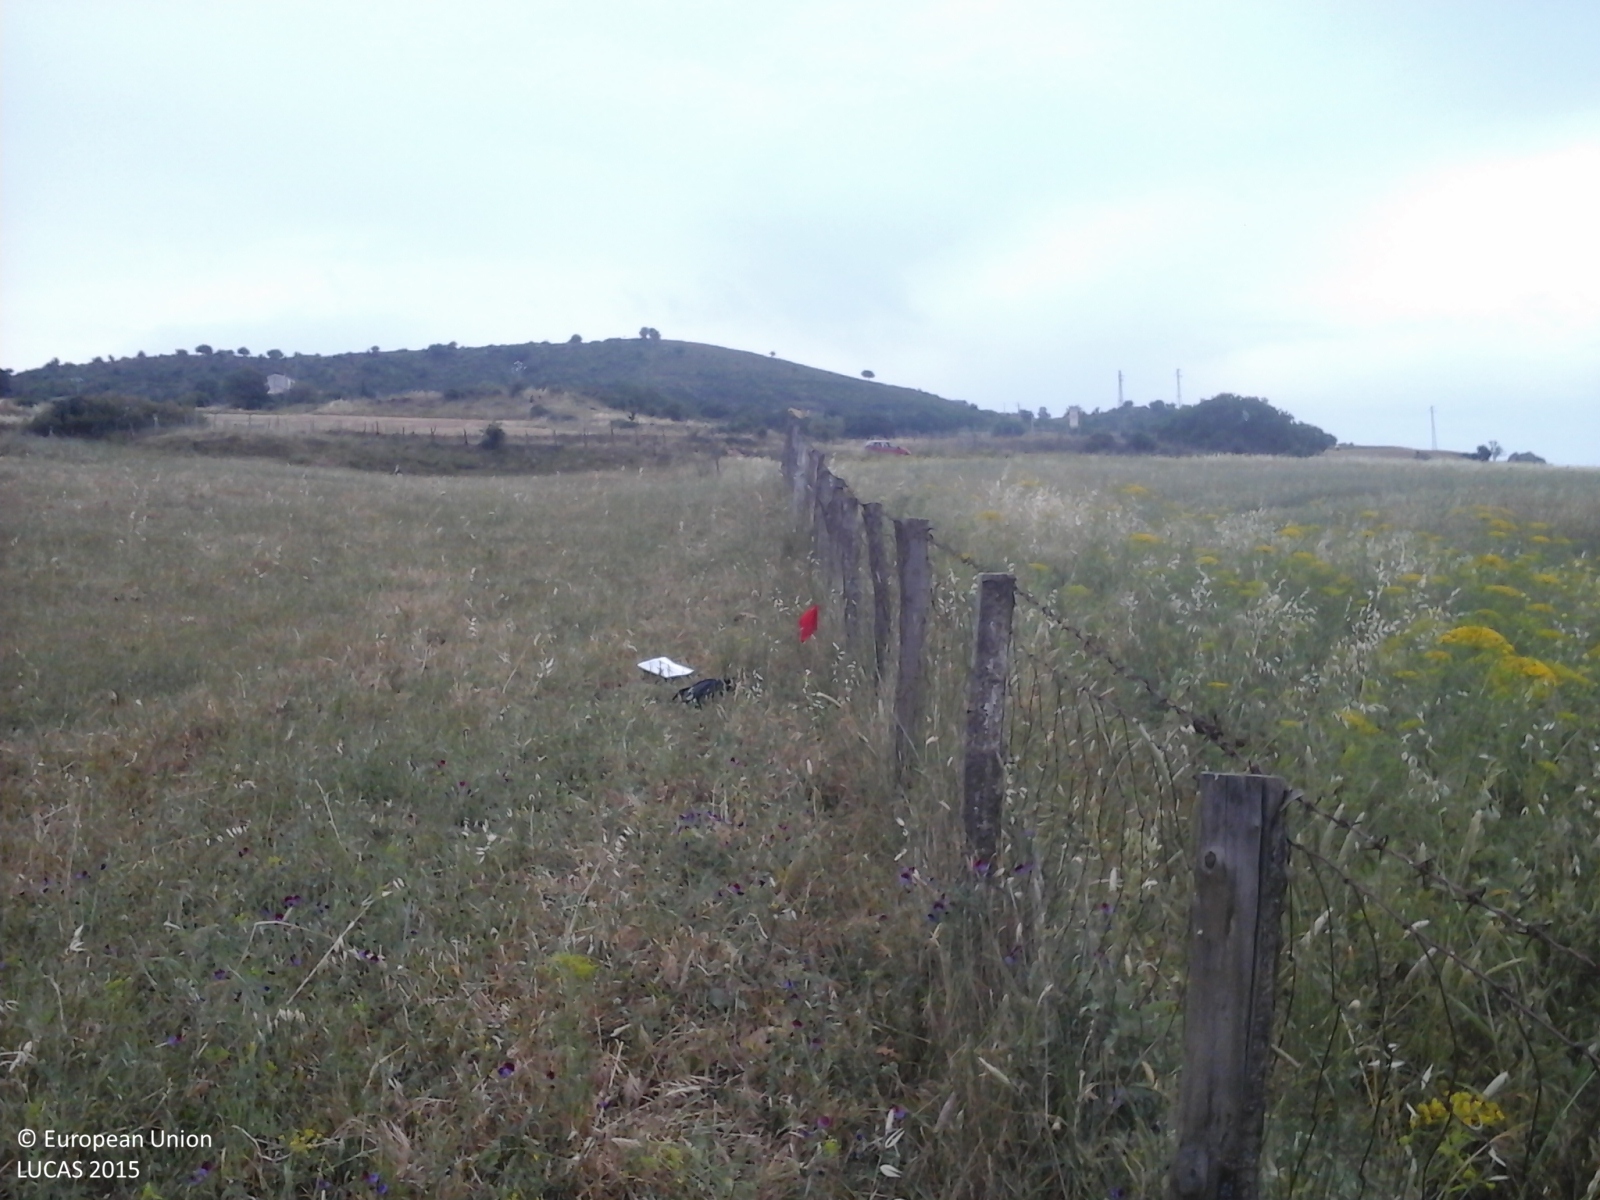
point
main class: Grassland
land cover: Grassland without tree/shrub cover
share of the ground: > 75 %
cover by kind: herbaceous plants 100 %
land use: Agriculture (excluding fallow land and kitchen gardens)
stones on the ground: 10 - 25 %
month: June
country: IT
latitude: 37.7523
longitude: 14.4516
